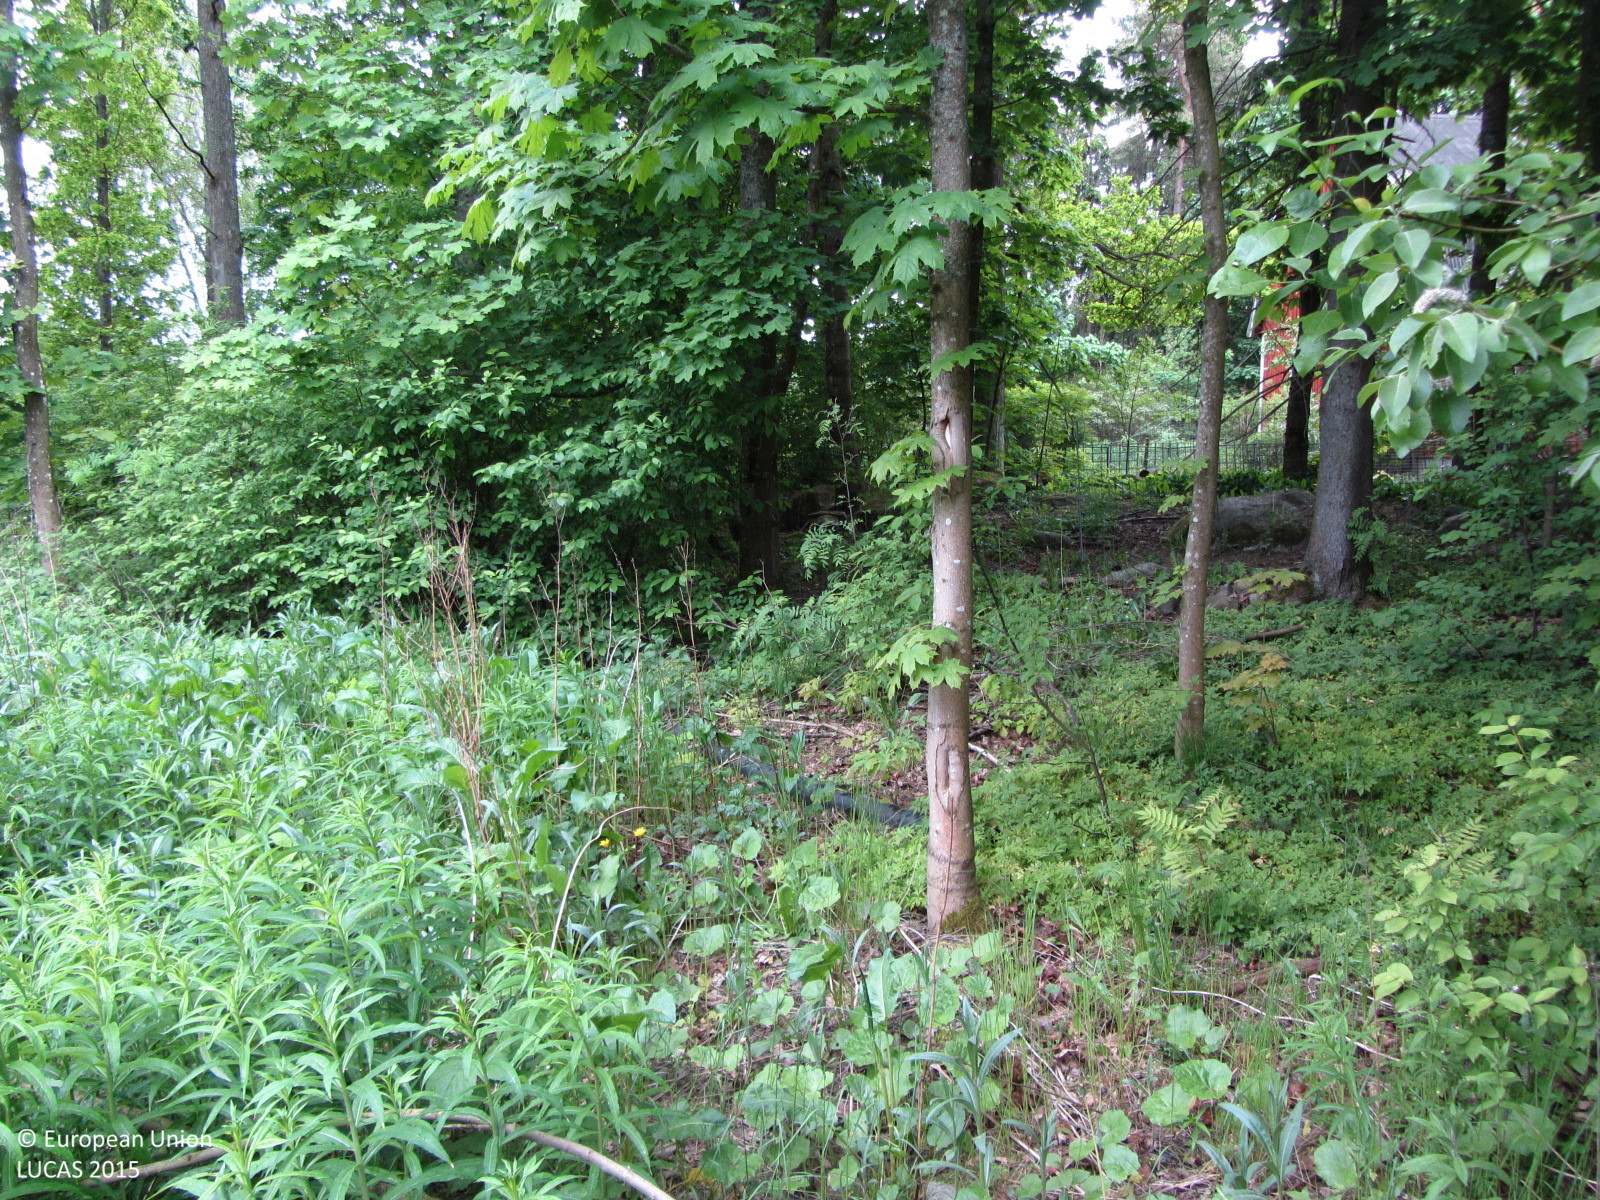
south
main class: Grassland
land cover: Spontaneously vegetated surfaces
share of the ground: > 75 %
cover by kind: herbaceous plants 100 %
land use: Semi-natural and natural areas not in use
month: June
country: FI
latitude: 60.2211
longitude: 24.7899
